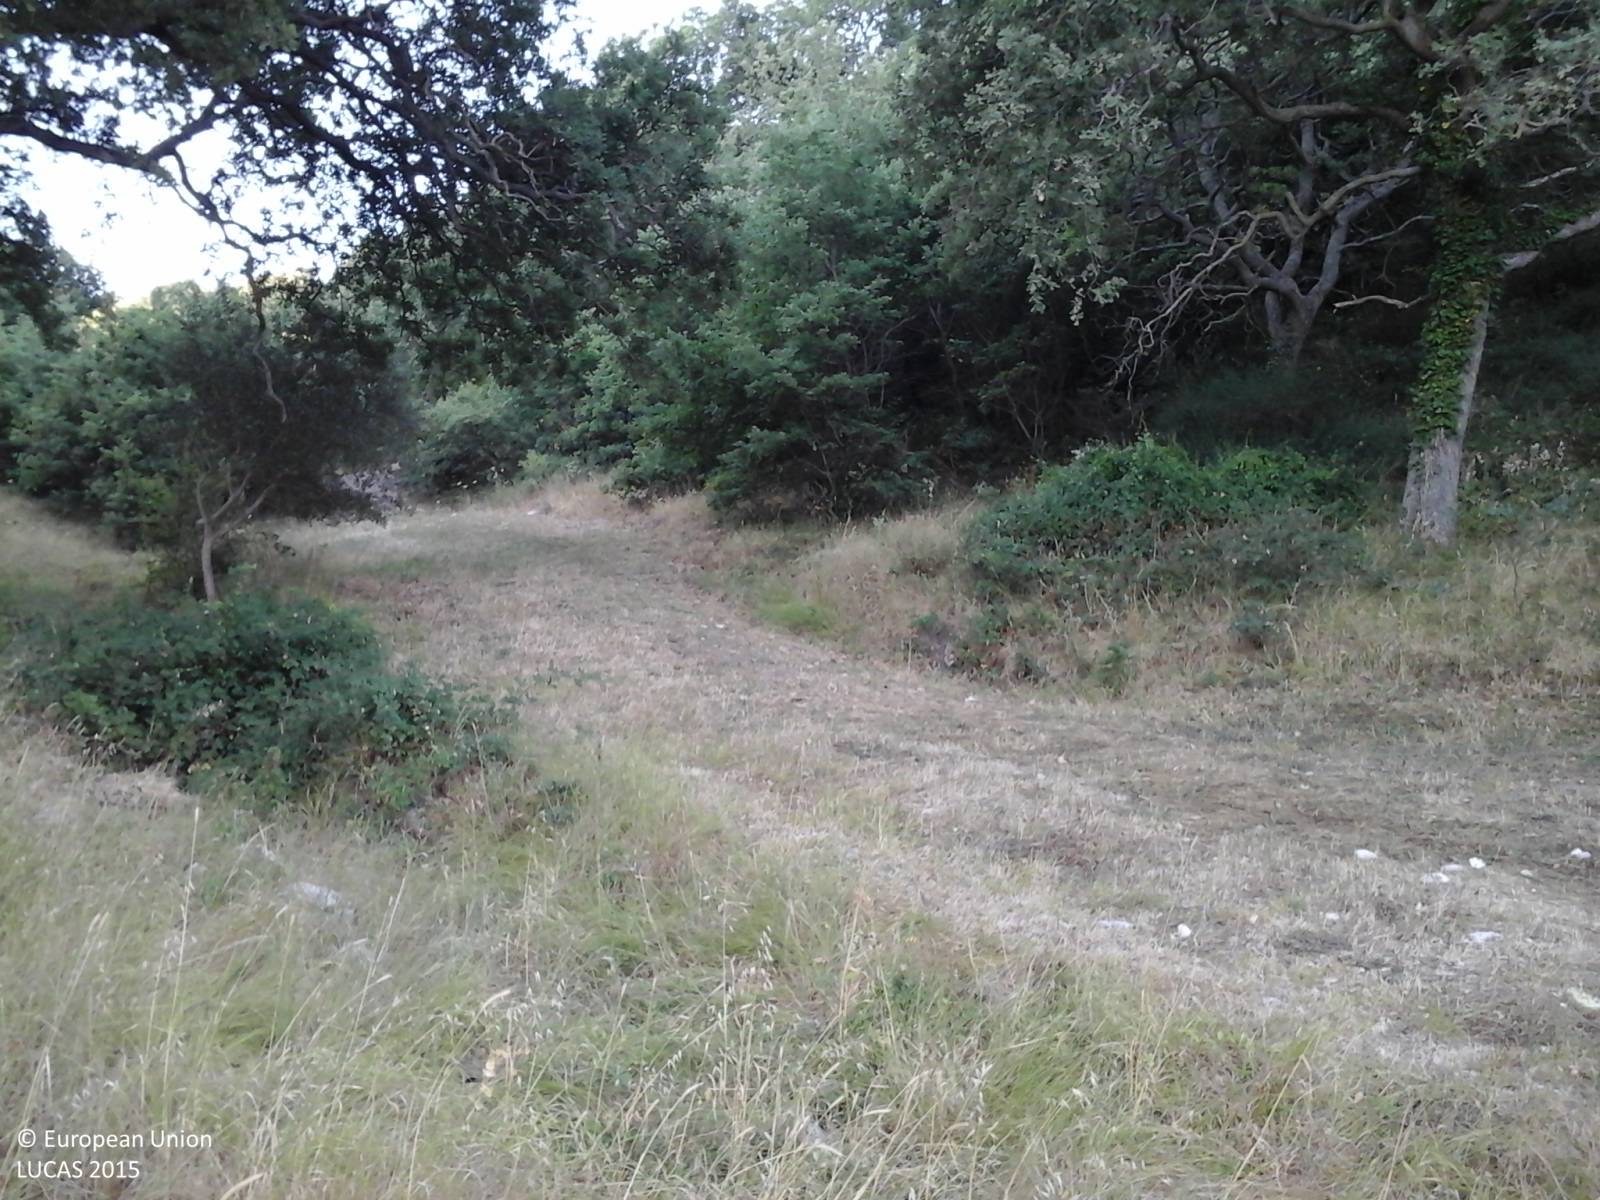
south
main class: Grassland
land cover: Grassland without tree/shrub cover
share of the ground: 25 - 50 %
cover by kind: herbaceous plants 100 %
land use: Agriculture (excluding fallow land and kitchen gardens)
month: July
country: IT
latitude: 40.7488
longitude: 8.8095
